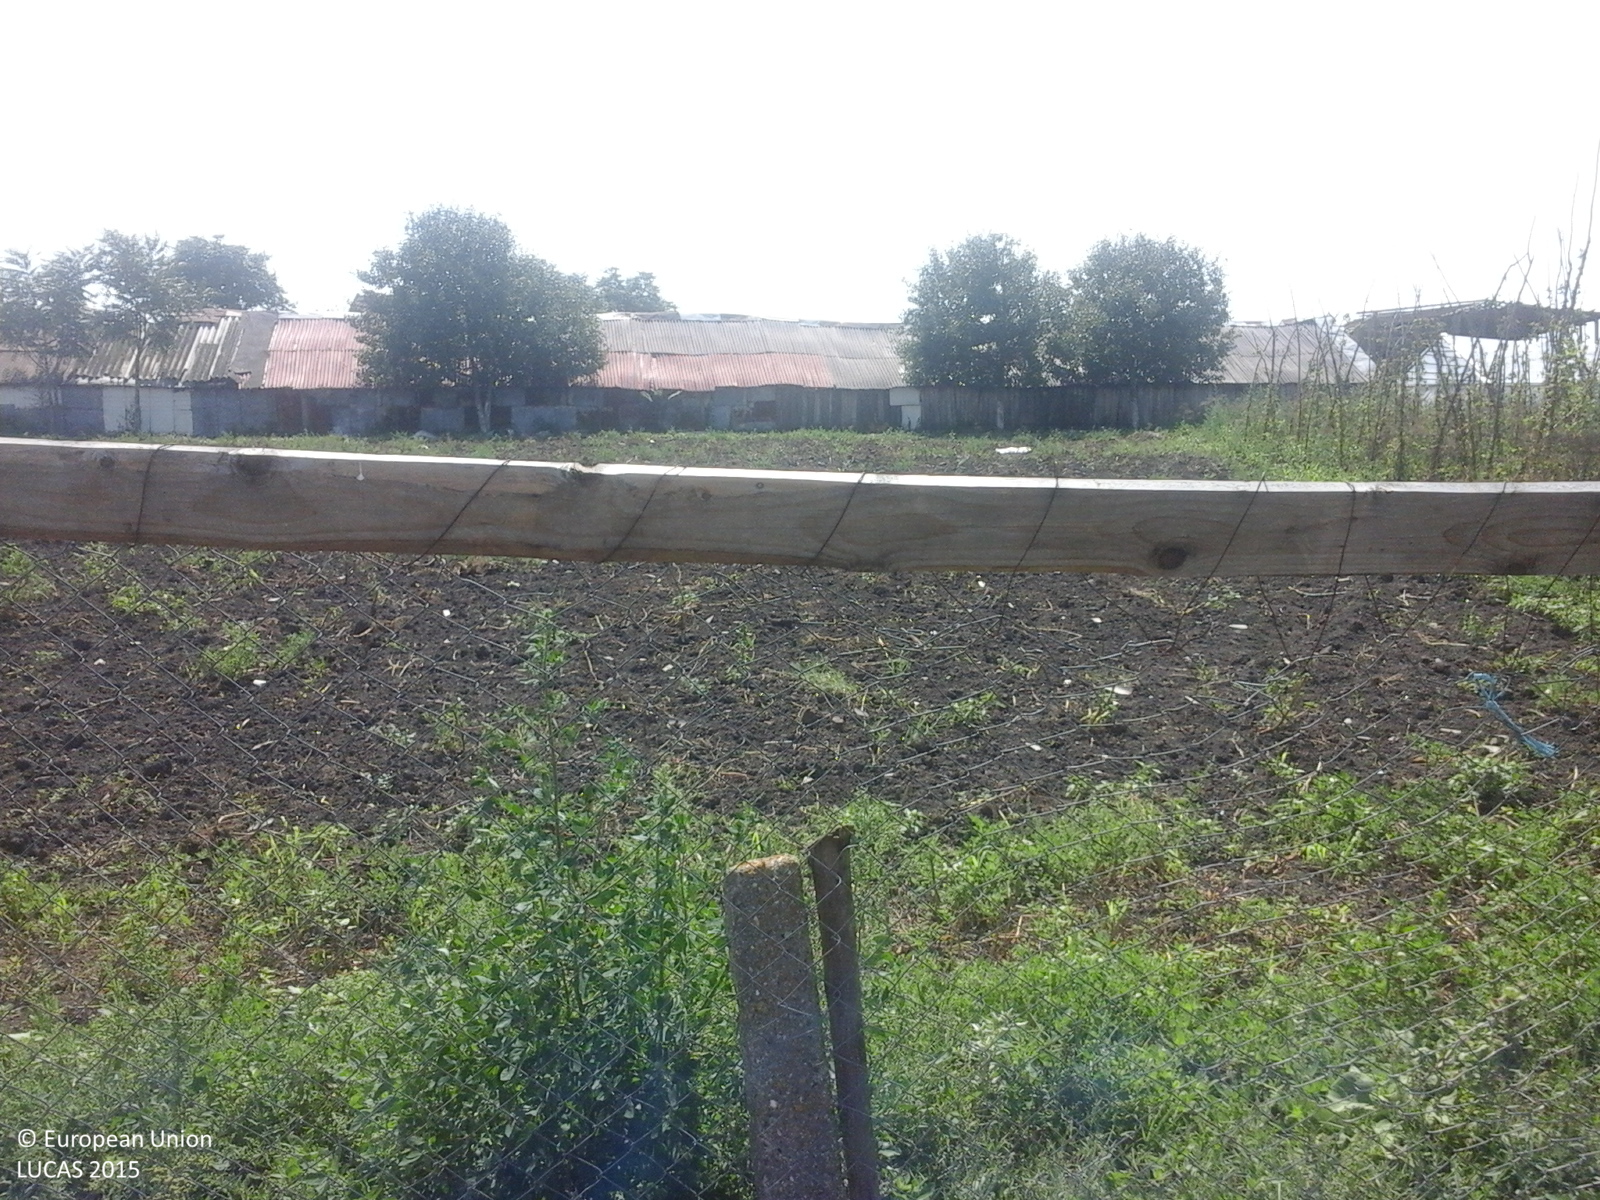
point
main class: Cropland
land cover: Potatoes
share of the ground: > 75 %
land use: Agriculture (excluding fallow land and kitchen gardens)
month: August
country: RO
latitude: 46.4363
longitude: 21.3457
